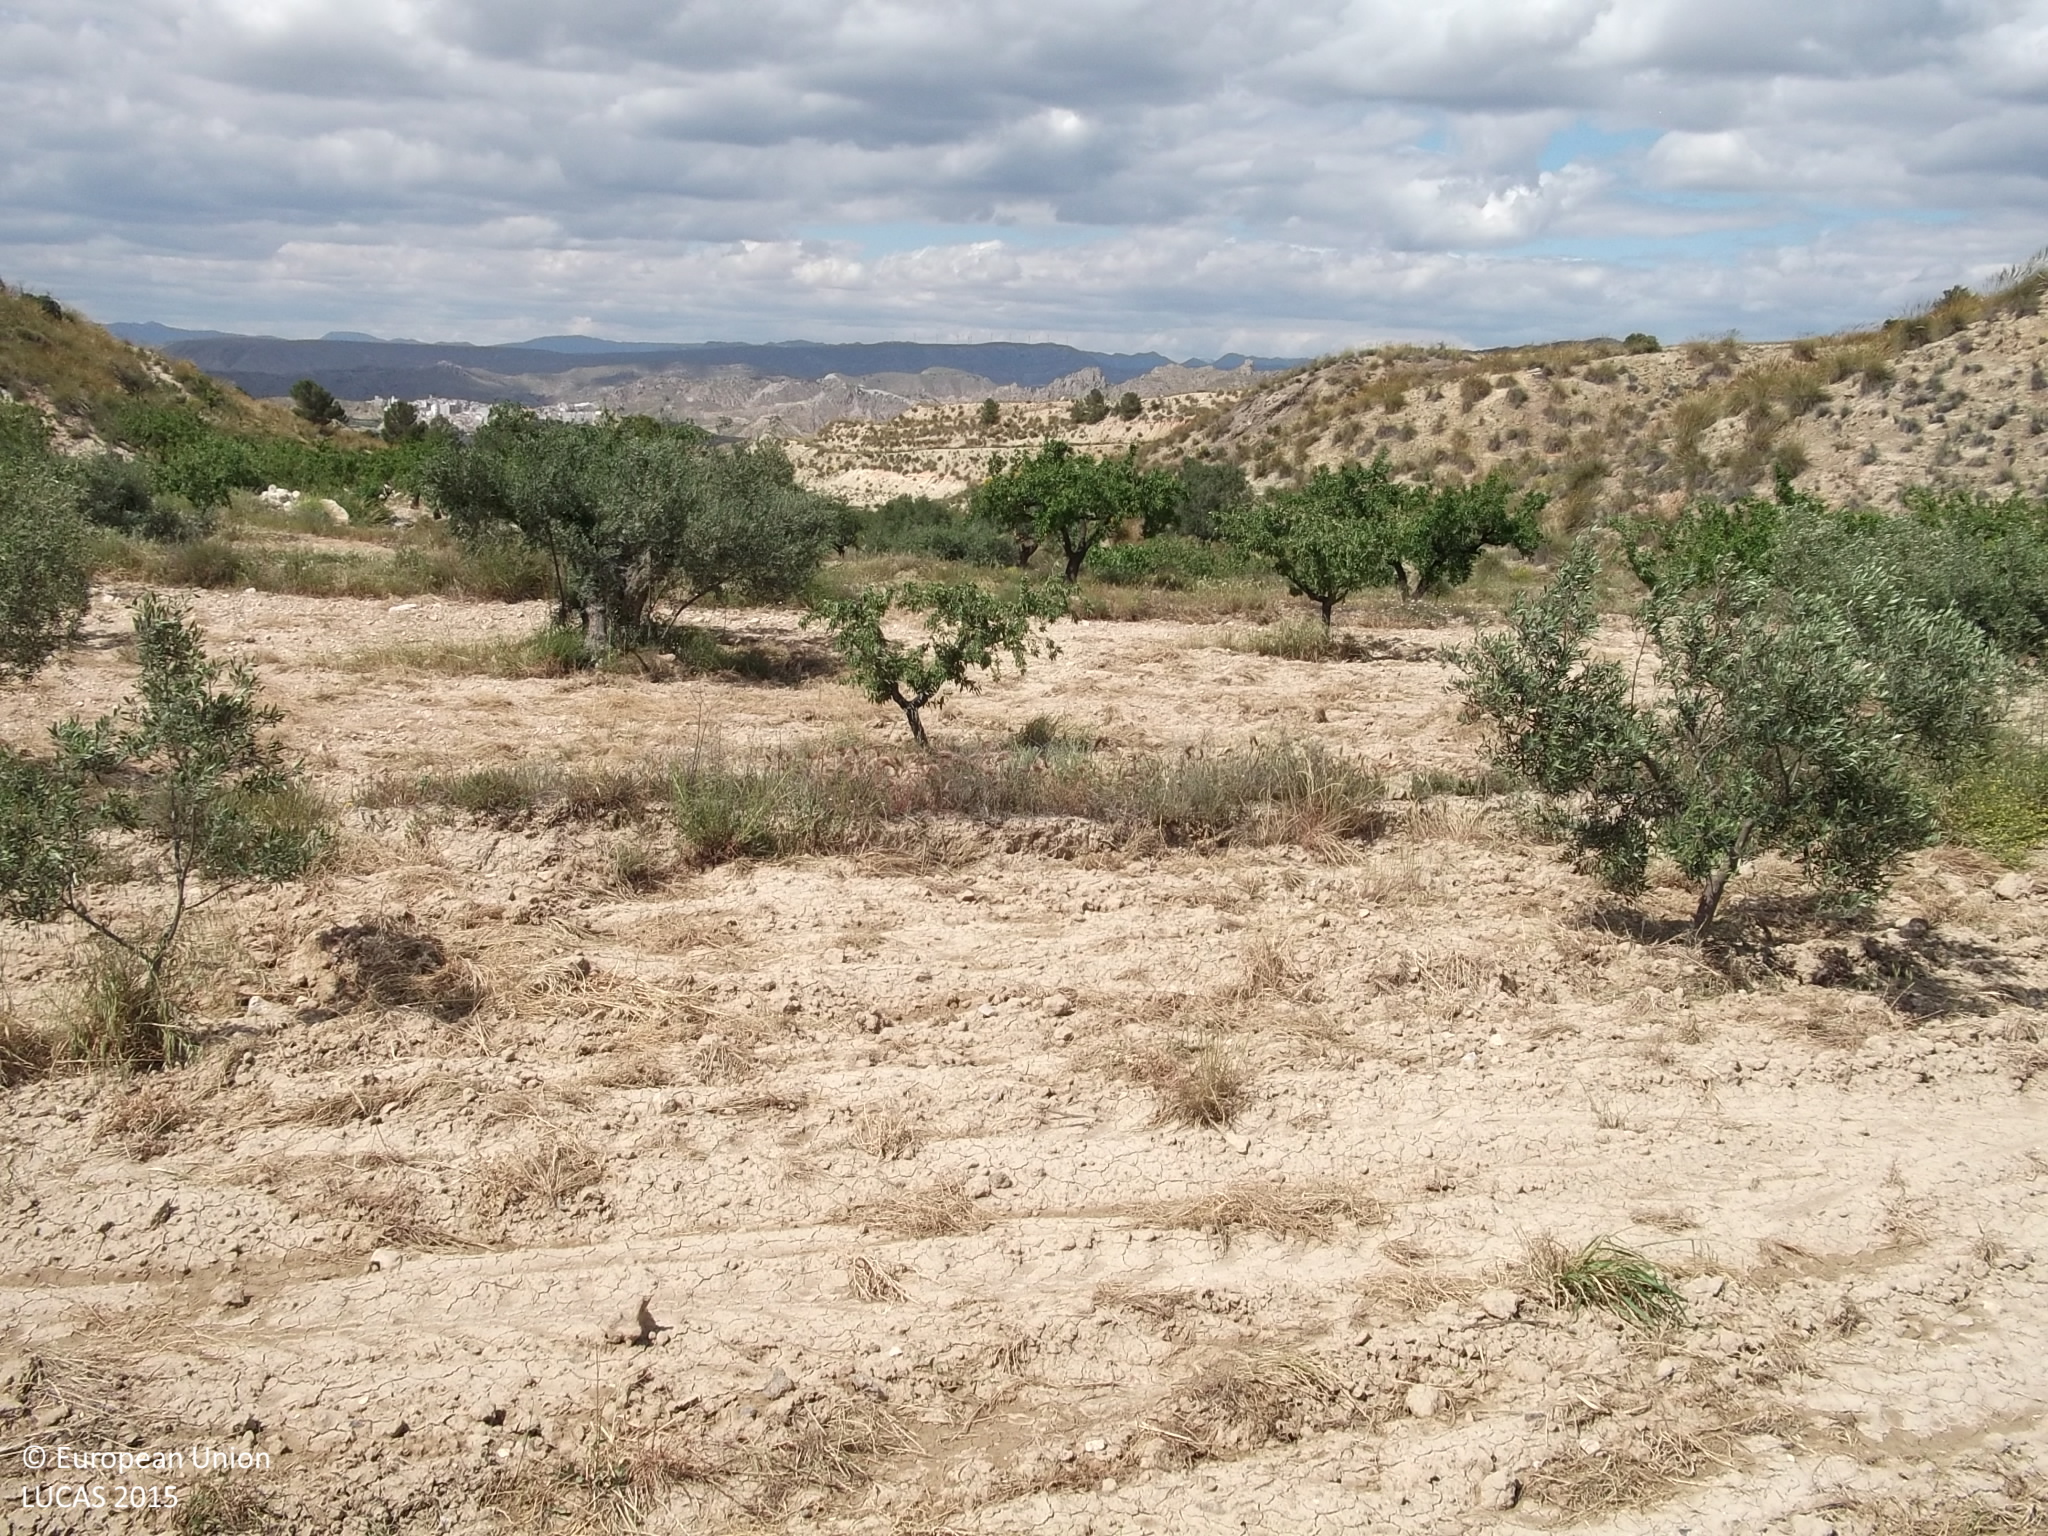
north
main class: Cropland
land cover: Olive groves
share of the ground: 10 - 25 %
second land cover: Other bare soil
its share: > 75 %
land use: Agriculture (excluding fallow land and kitchen gardens)
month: April
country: ES
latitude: 38.1586
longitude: -1.3884
